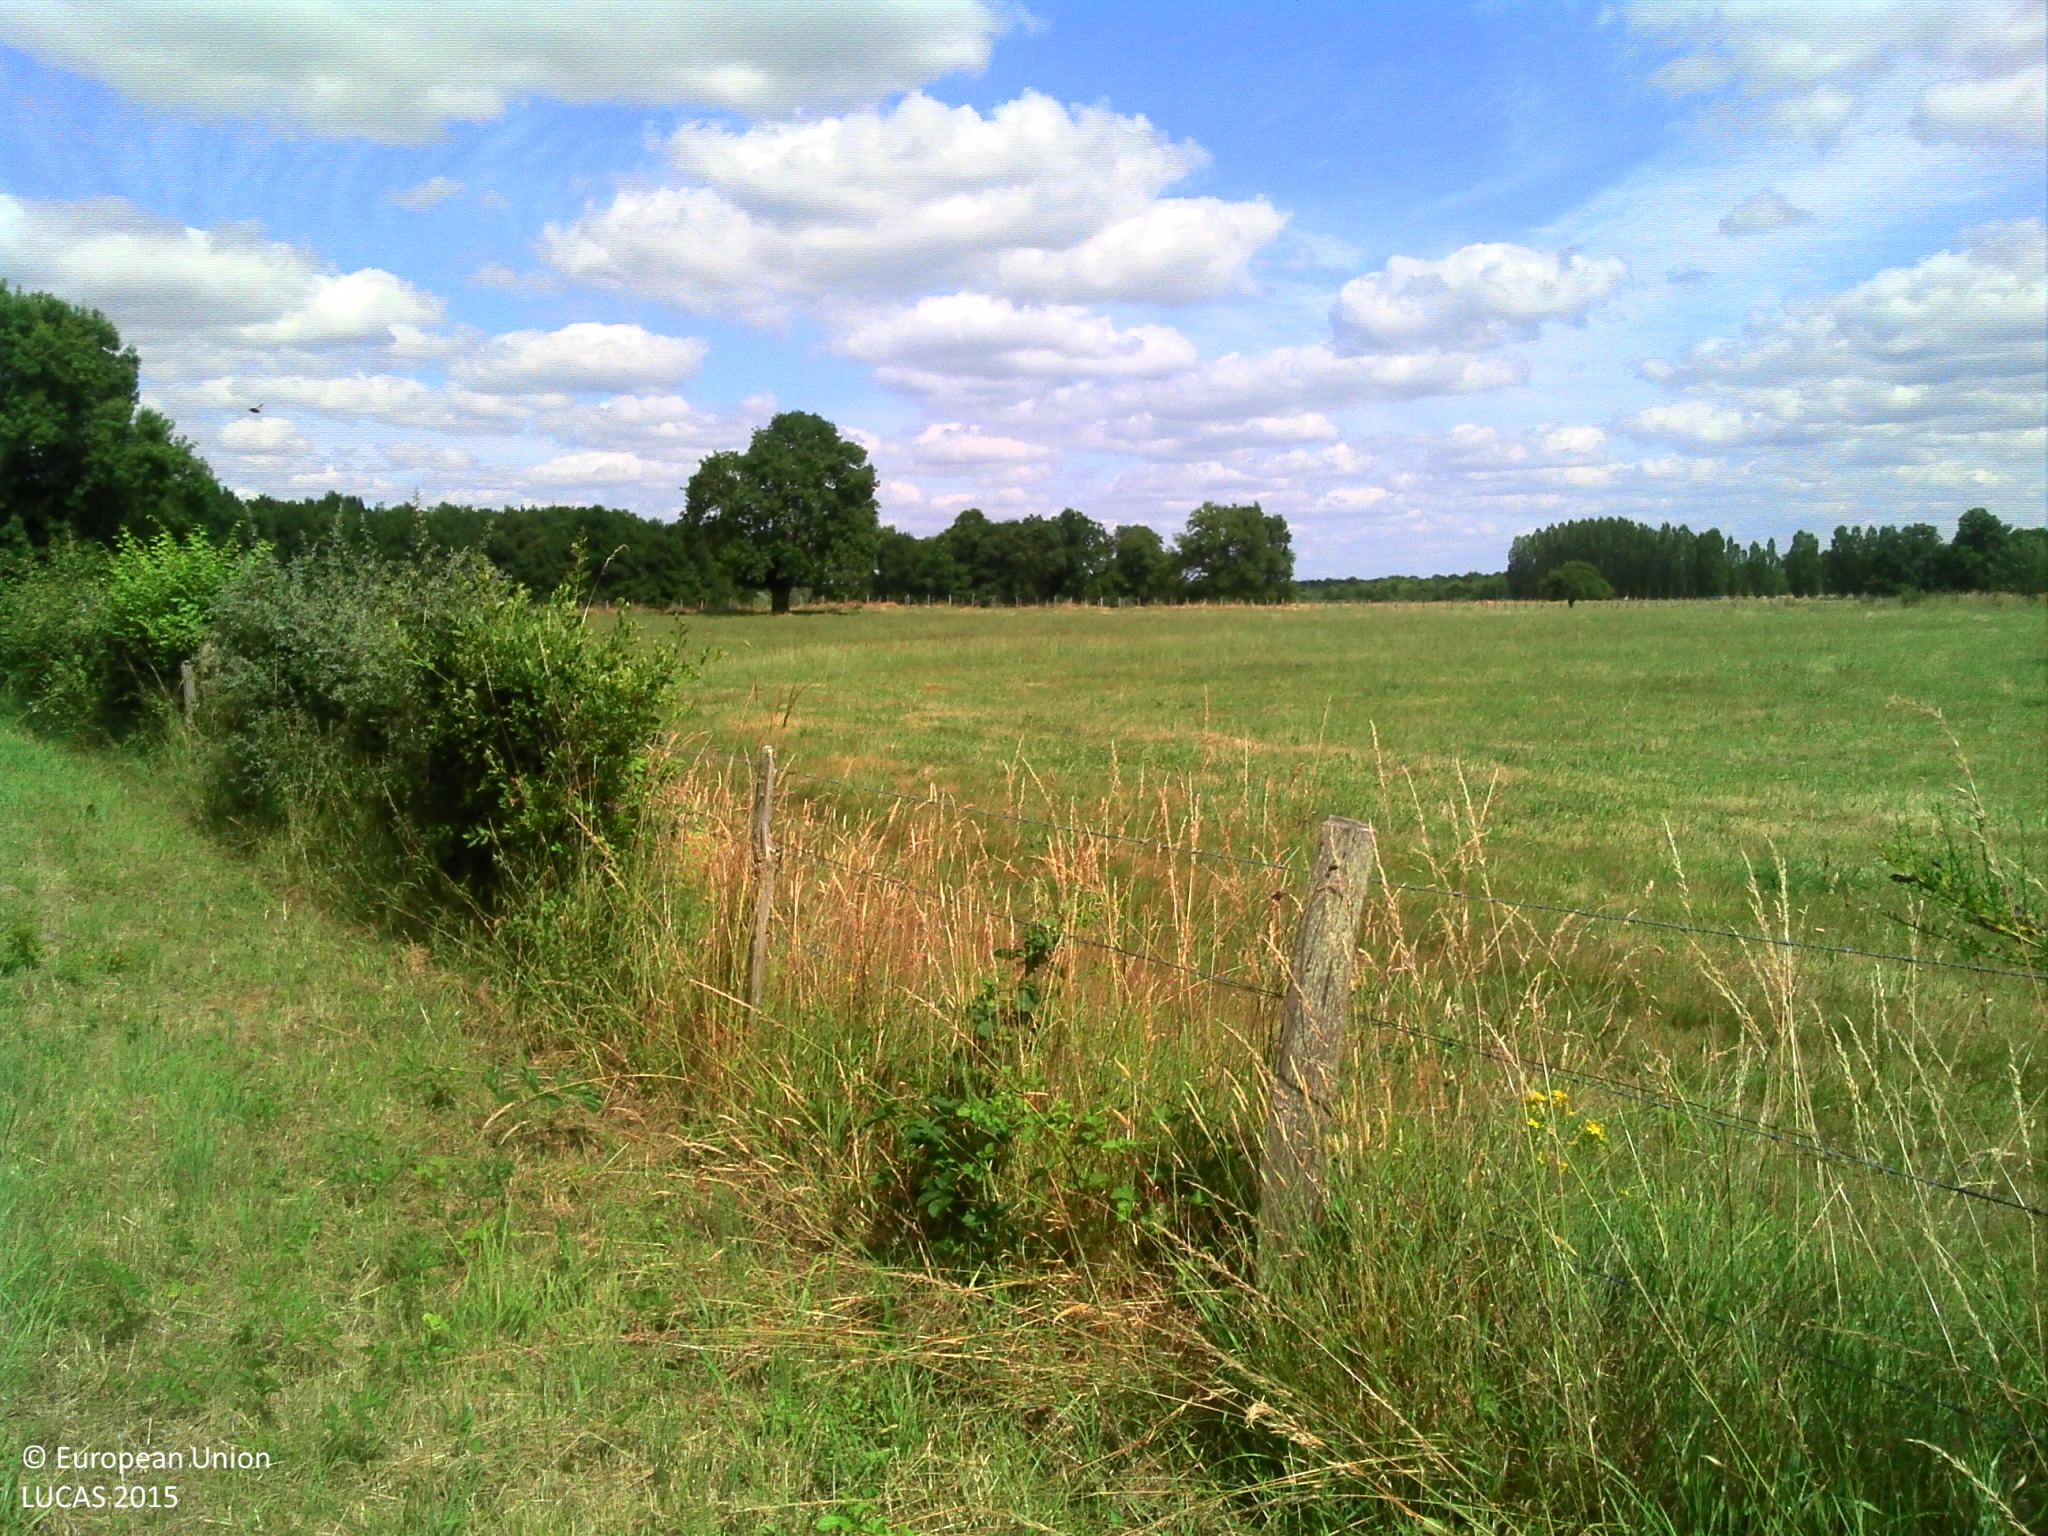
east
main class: Grassland
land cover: Grassland without tree/shrub cover
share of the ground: > 75 %
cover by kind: herbaceous plants 100 %
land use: Agriculture (excluding fallow land and kitchen gardens)
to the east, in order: Grassland without tree/shrub cover; Fences; Grassland without tree/shrub cover; Fences; Grassland without tree/shrub cover; Inland fresh water bodies; Fences; Inland fresh water bodies; Grassland without tree/shrub cover
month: June
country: FR
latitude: 47.4714
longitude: 0.3313
